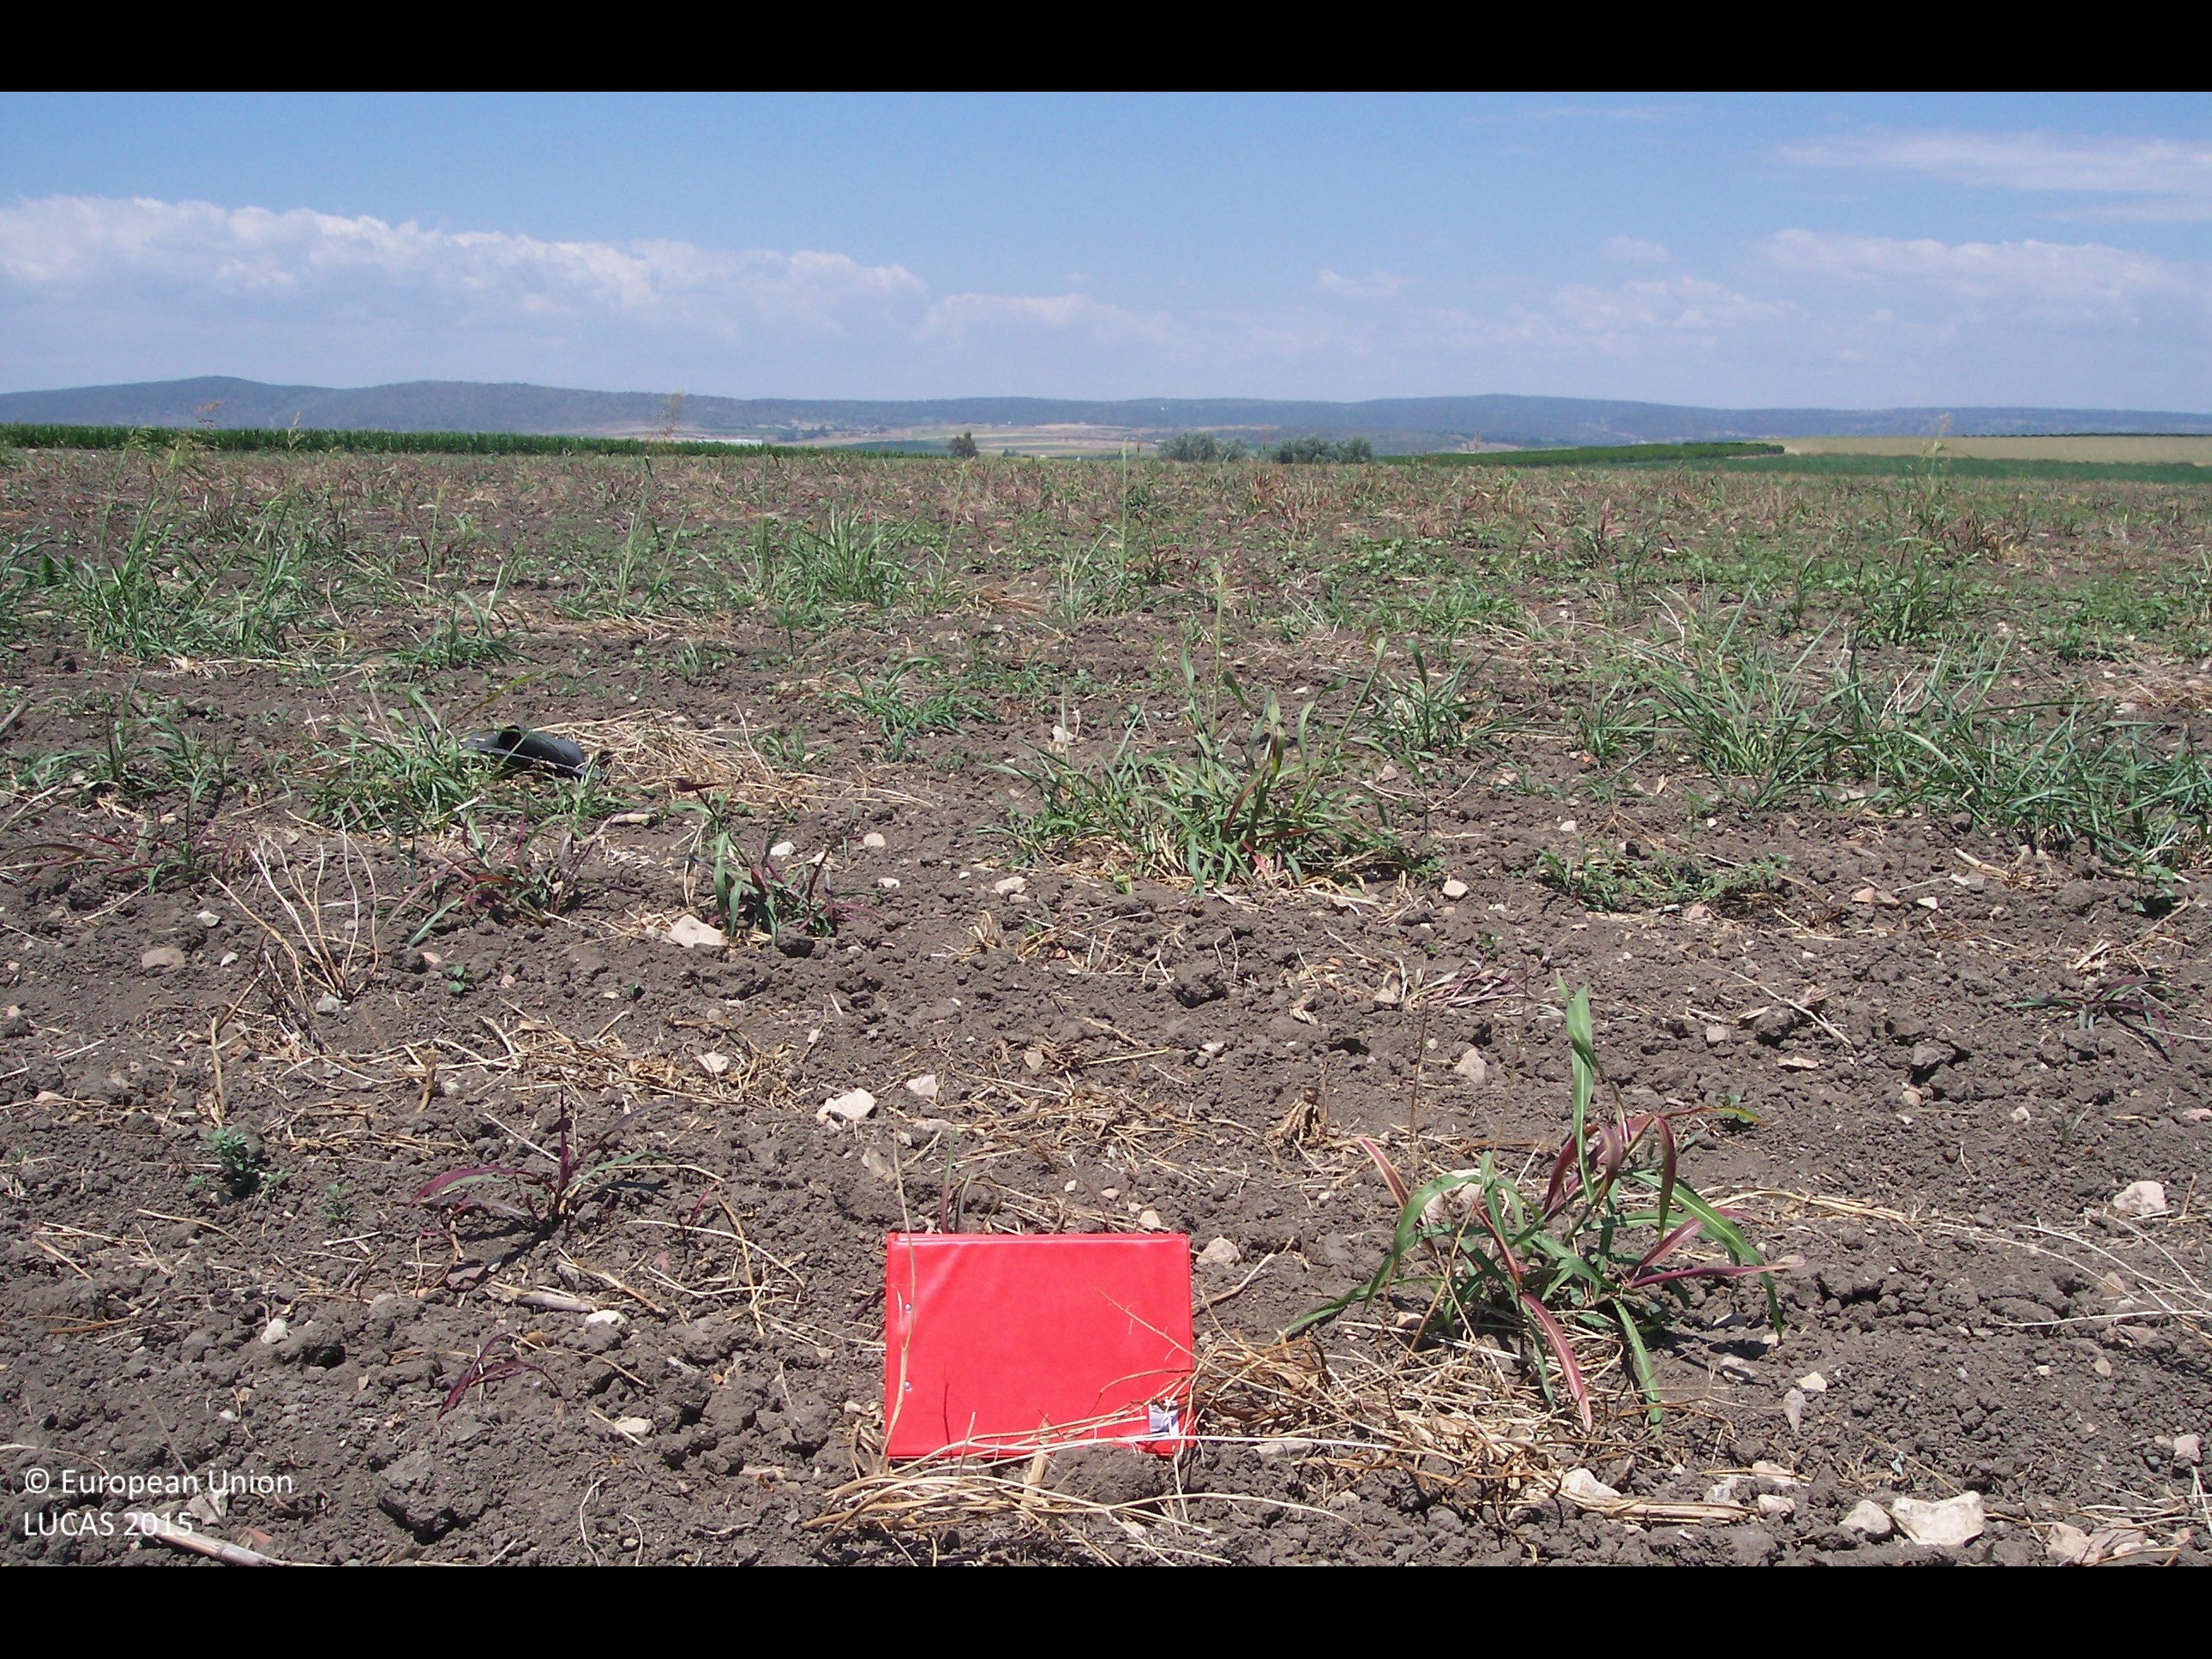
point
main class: Cropland
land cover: Cotton
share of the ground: < 10 %
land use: Agriculture (excluding fallow land and kitchen gardens)
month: May
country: ES
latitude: 37.5529
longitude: -5.9527
